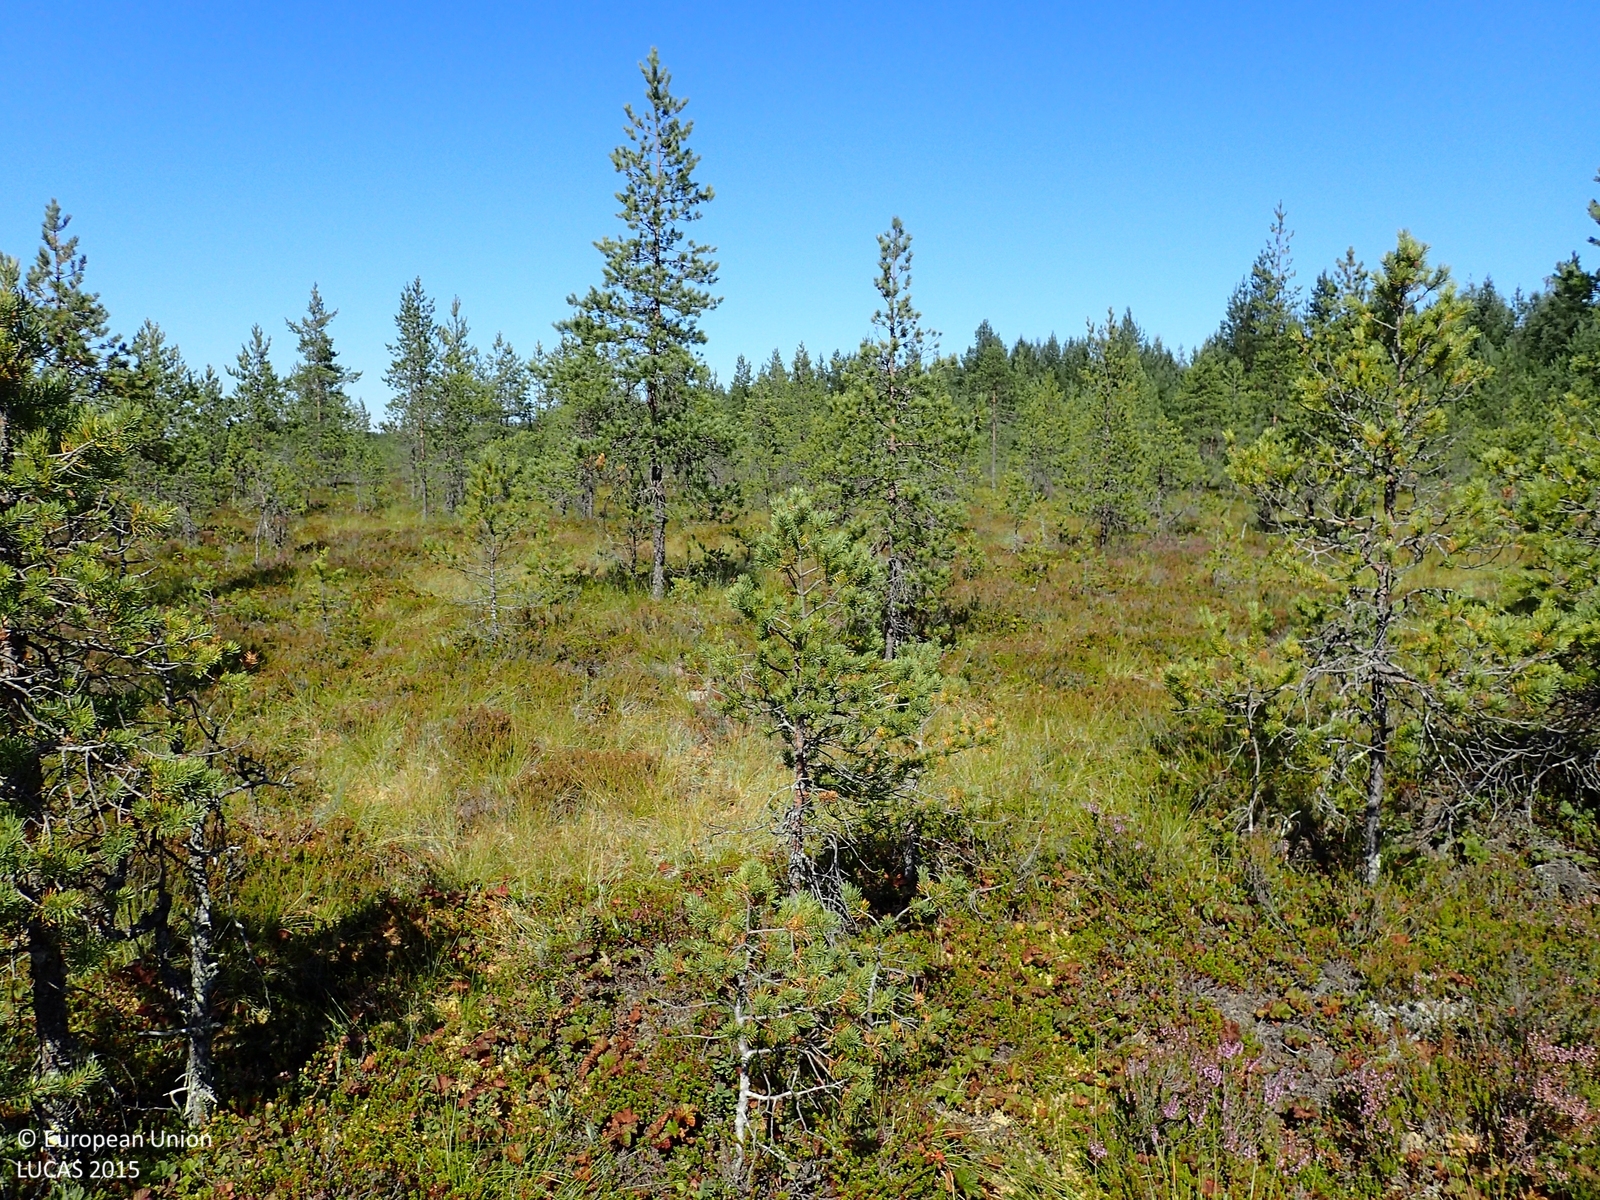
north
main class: Woodland
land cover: Pine dominated coniferous woodland
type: mire and swamp forests
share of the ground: 25 - 50 %
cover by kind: shrubs 50 %, coniferous forest trees 25 %, herbaceous plants 20 %, lichens and mosses 5 %
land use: Amenities, museums, leisure
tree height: < 5 m
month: August
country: FI
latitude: 62.5065
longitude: 22.5412
